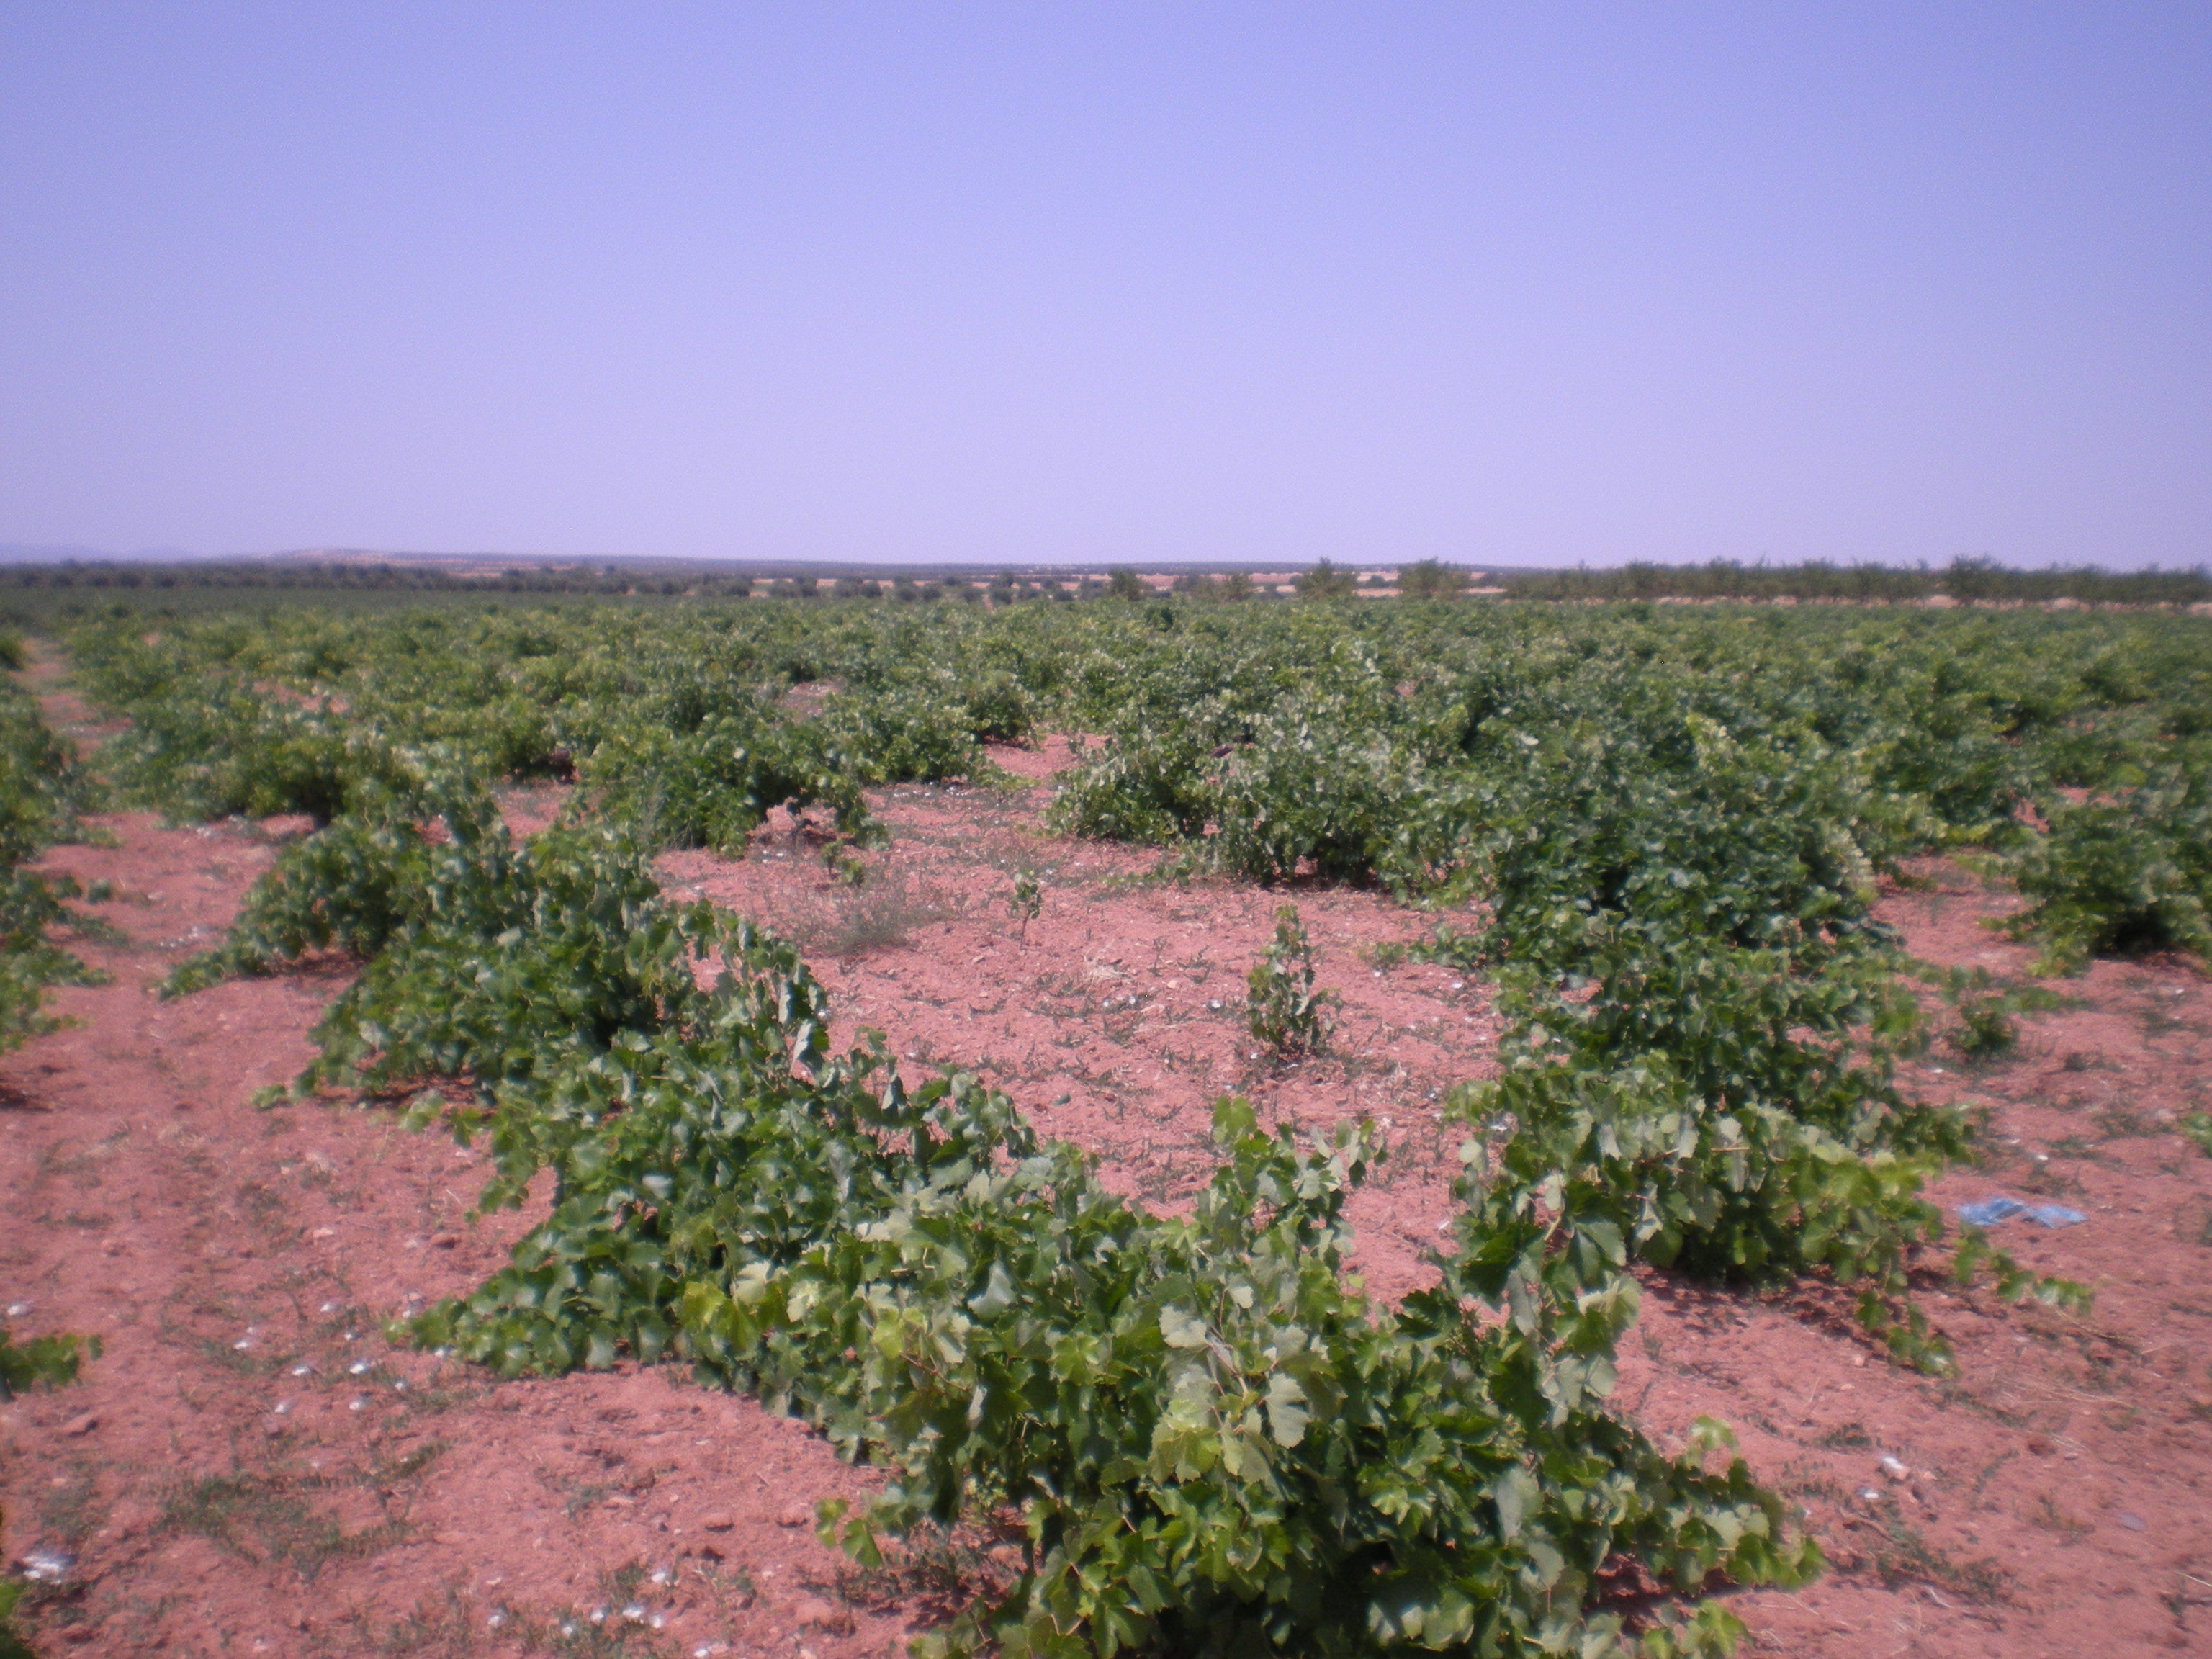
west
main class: Cropland
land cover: Vineyards
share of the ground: 10 - 25 %
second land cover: Spontaneously vegetated surfaces
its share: 10 - 25 %
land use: Agriculture (excluding fallow land and kitchen gardens)
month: July
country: ES
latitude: 39.4570
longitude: -3.3741
